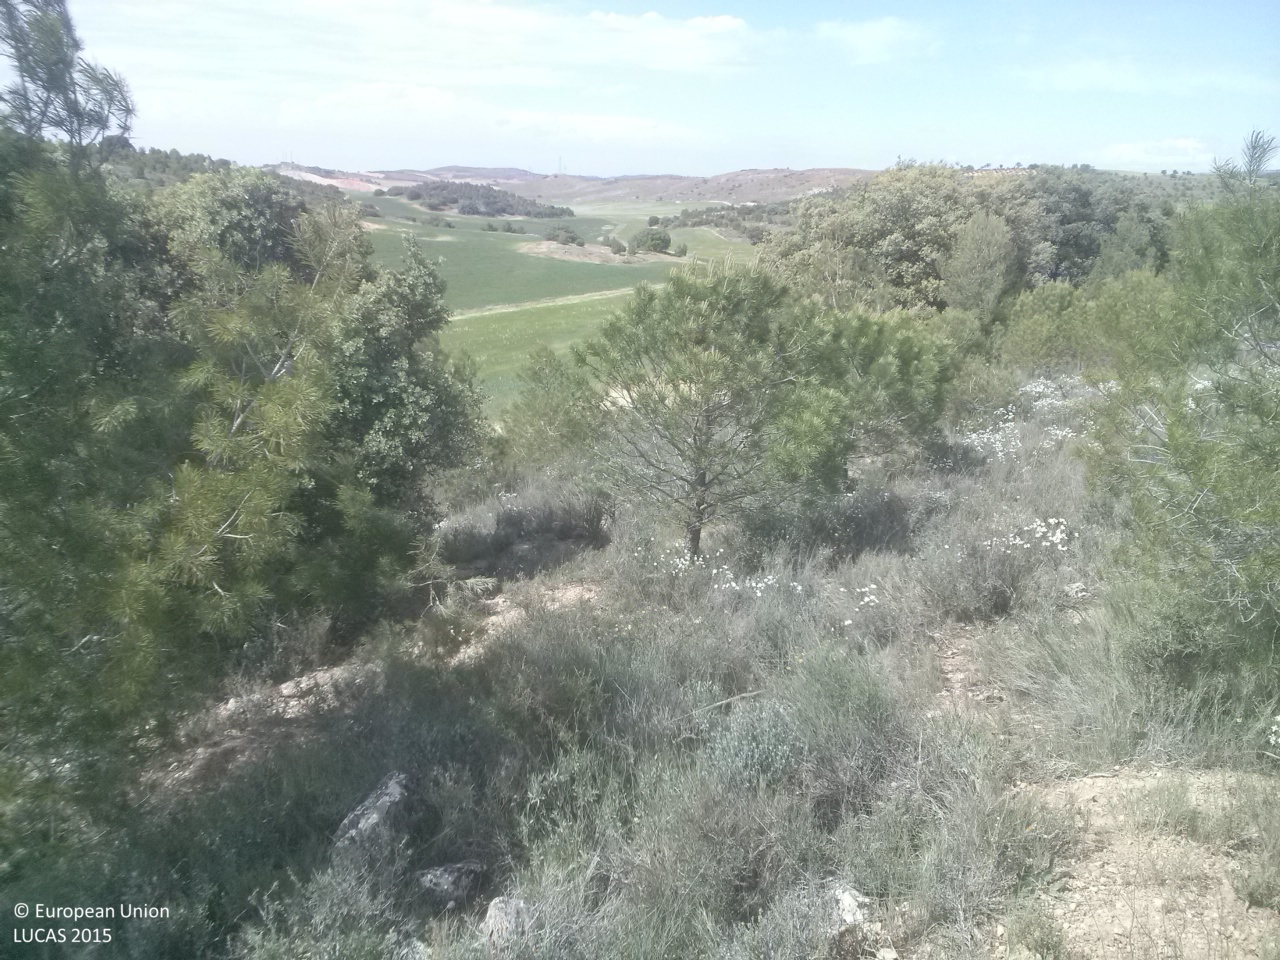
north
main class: Woodland
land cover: Pine dominated mixed woodland
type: coniferous forest of the mediterranean region
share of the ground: 10 - 25 %
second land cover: Shrubland without tree cover
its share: 50 - 75 %
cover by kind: shrubs 55 %, coniferous forest trees 20 %, herbaceous plants 15 %, broadleaved forest trees 10 %
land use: Forestry
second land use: Agriculture (excluding fallow land and kitchen gardens)
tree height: < 5 m
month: May
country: ES
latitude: 40.0158
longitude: -2.8985
